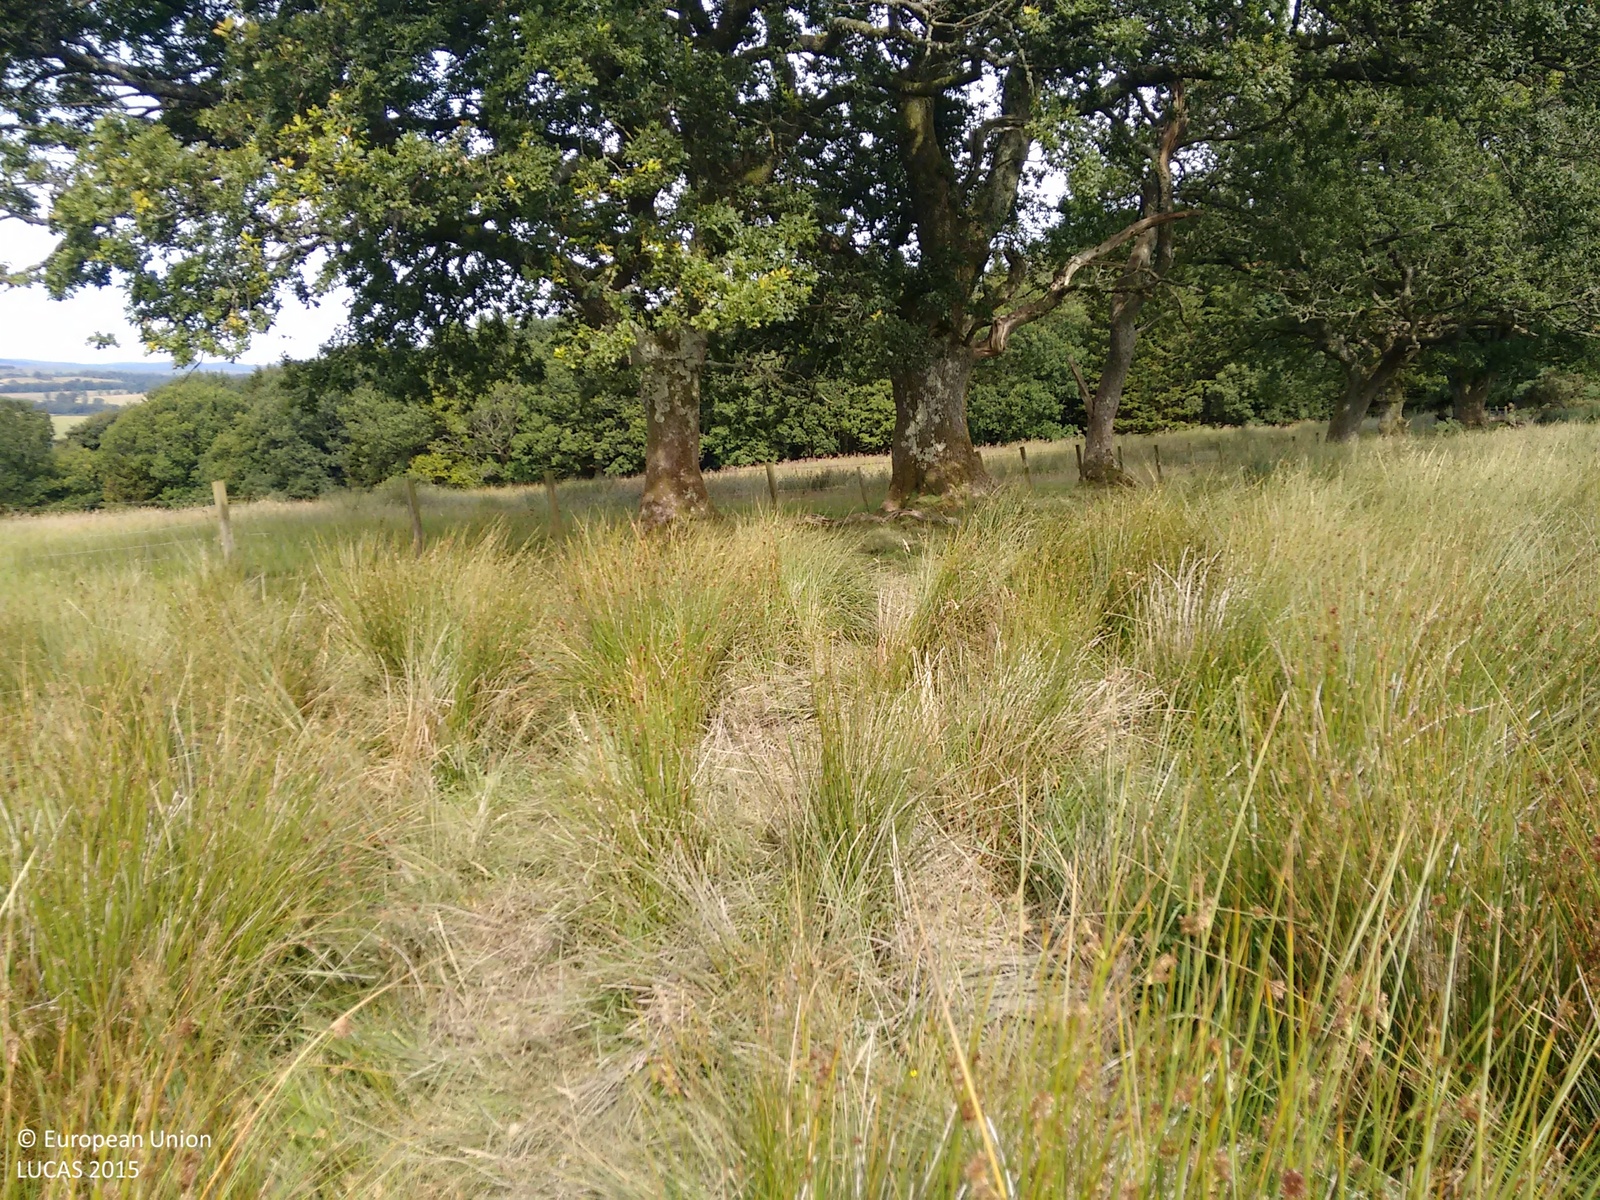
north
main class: Grassland
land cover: Grassland without tree/shrub cover
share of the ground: > 75 %
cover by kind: herbaceous plants 100 %
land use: Agriculture (excluding fallow land and kitchen gardens)
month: August
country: GB
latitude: 55.2082
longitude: -3.3880
